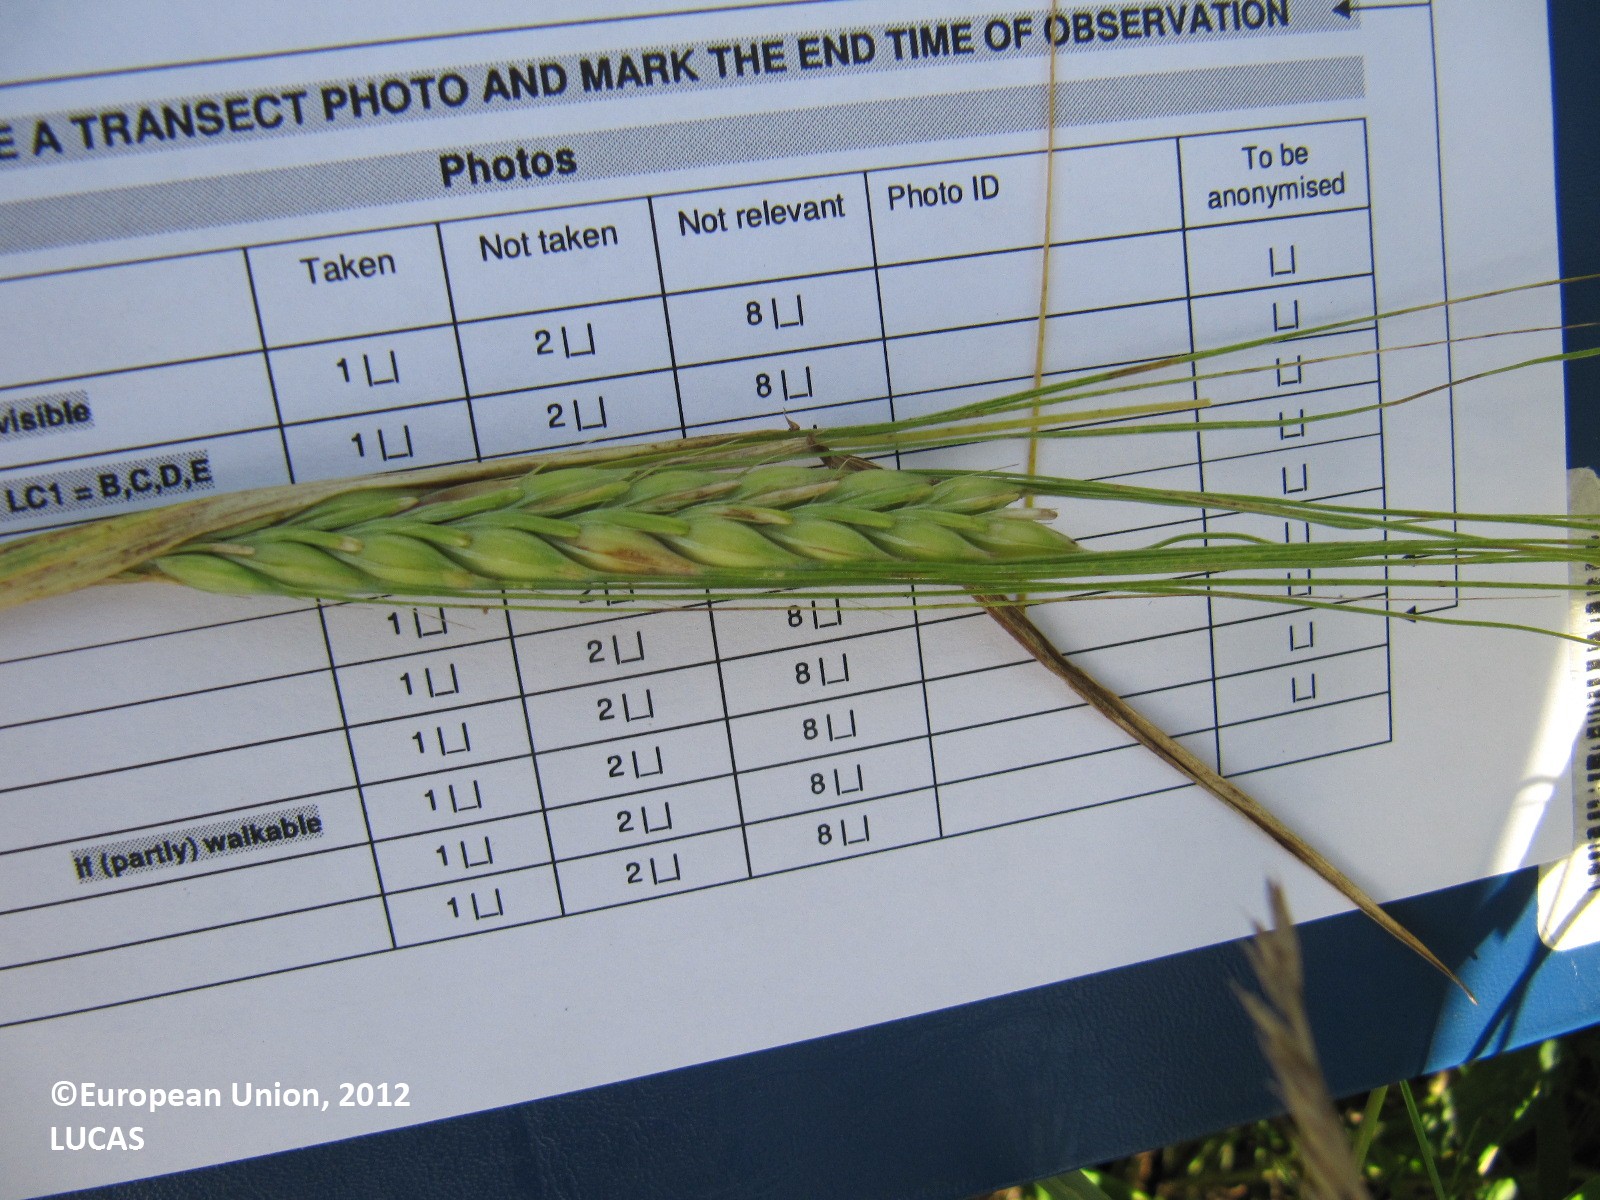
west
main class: Cropland
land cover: Barley
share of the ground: > 75 %
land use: Agriculture (excluding fallow land and kitchen gardens)
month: August
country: FI
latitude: 60.3097
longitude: 23.1681
